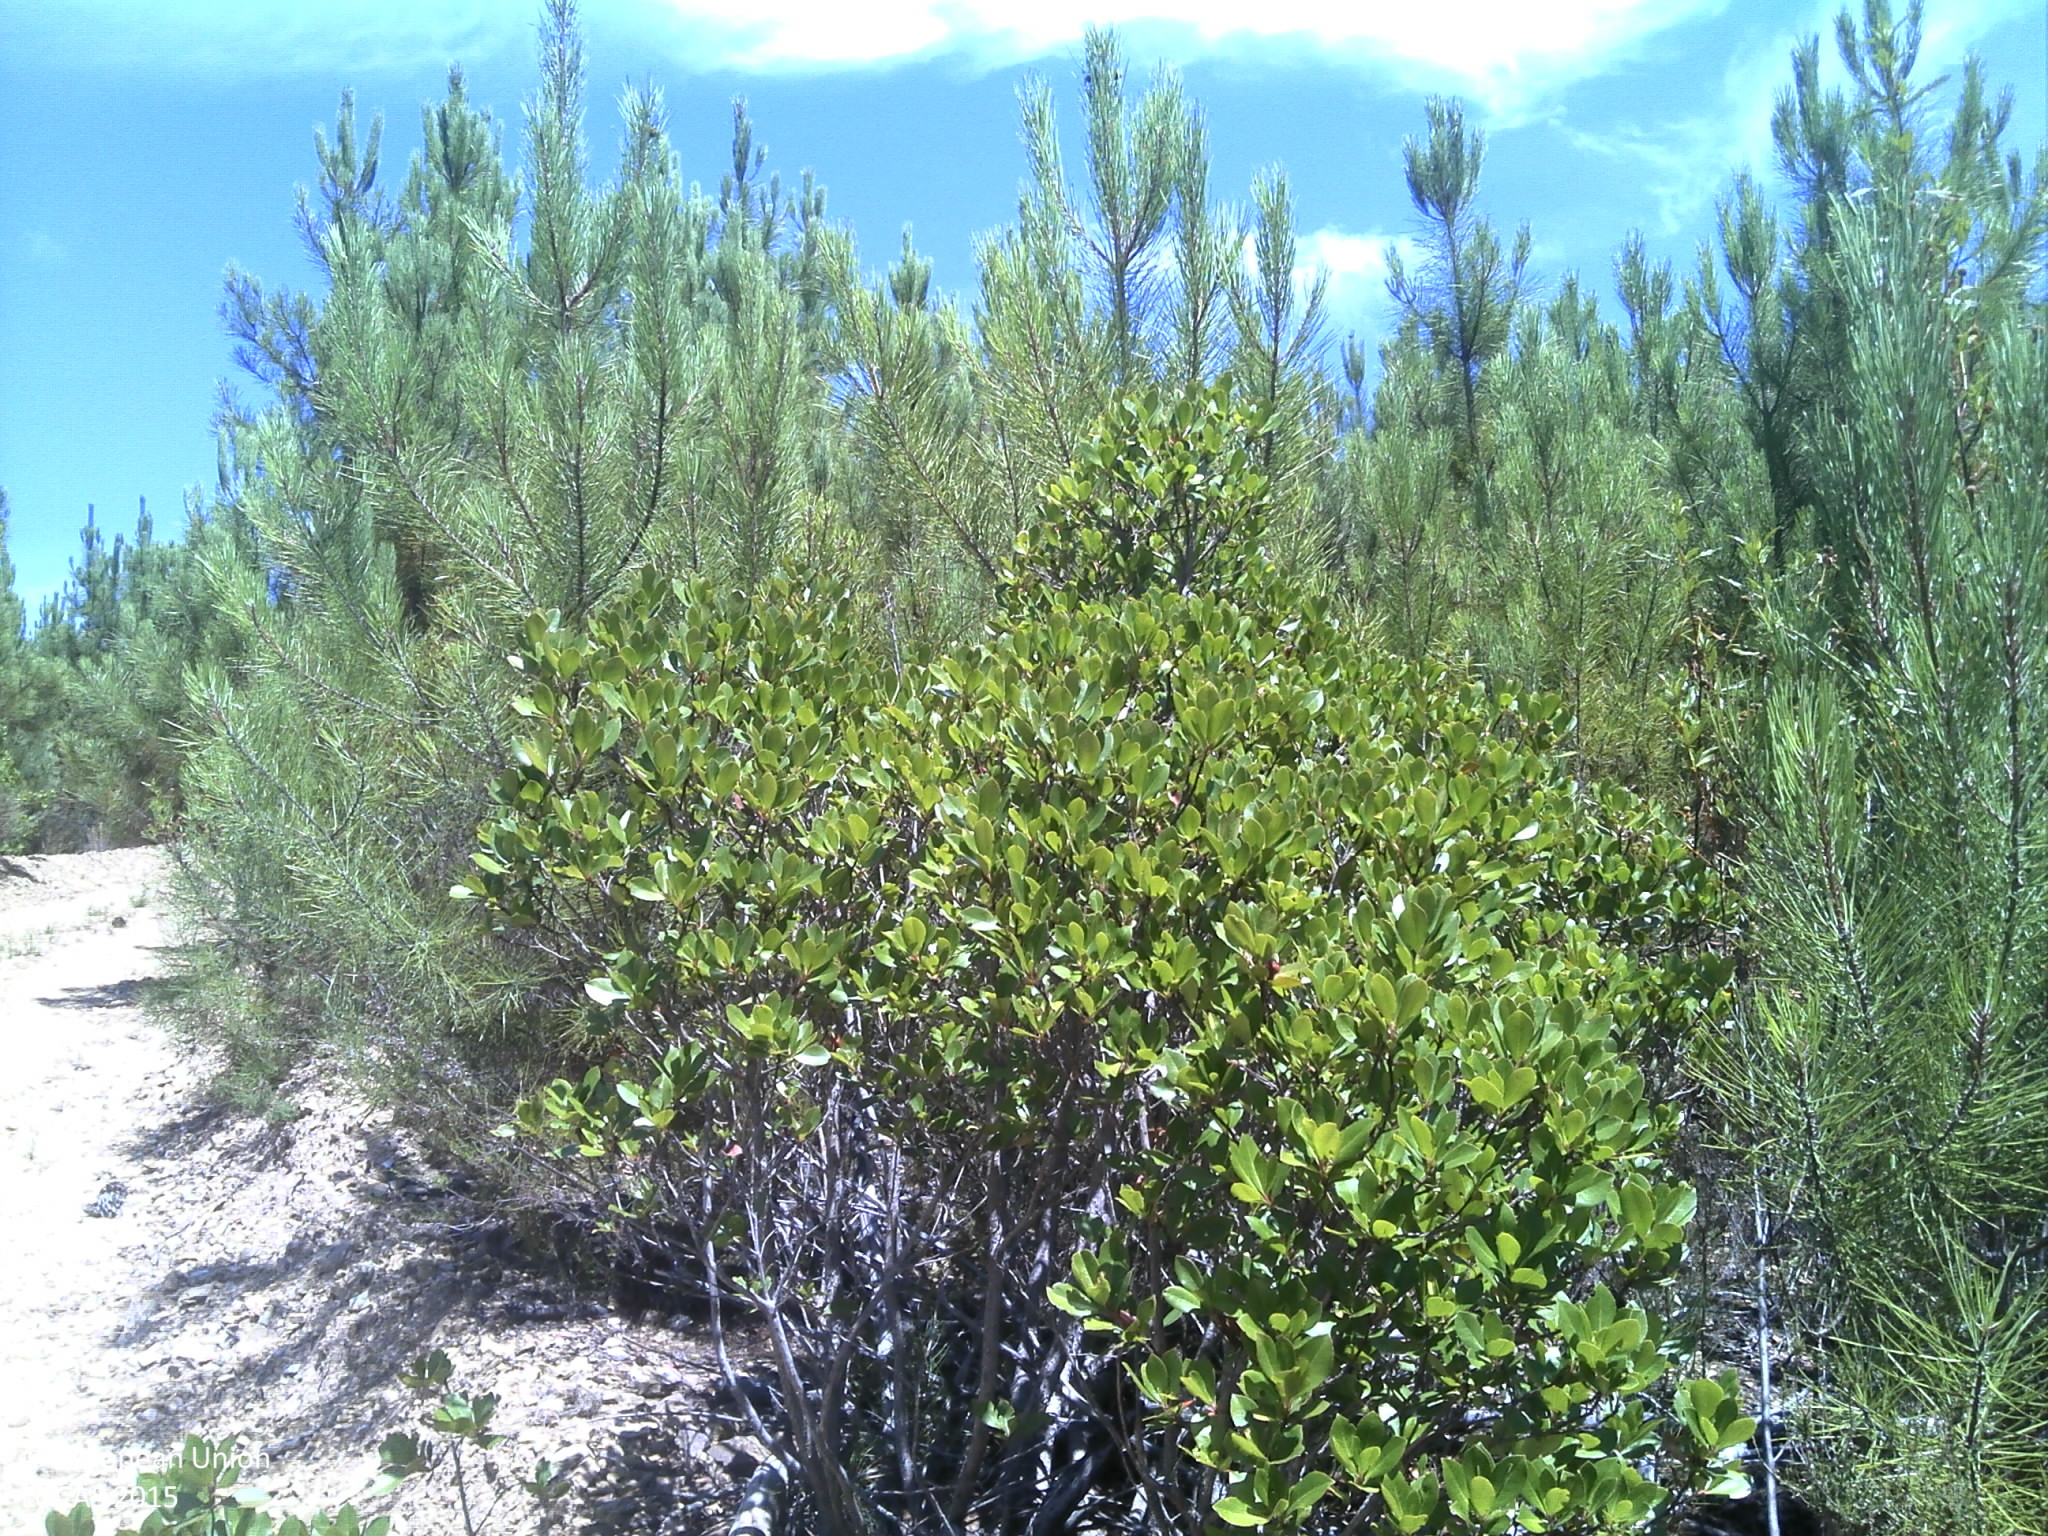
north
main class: Woodland
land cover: Pine dominated coniferous woodland
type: coniferous forest of the mediterranean region
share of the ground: 50 - 75 %
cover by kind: coniferous forest trees 70 %, shrubs 25 %
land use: Forestry
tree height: > 5 m
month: July
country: PT
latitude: 40.0480
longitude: -7.8947
